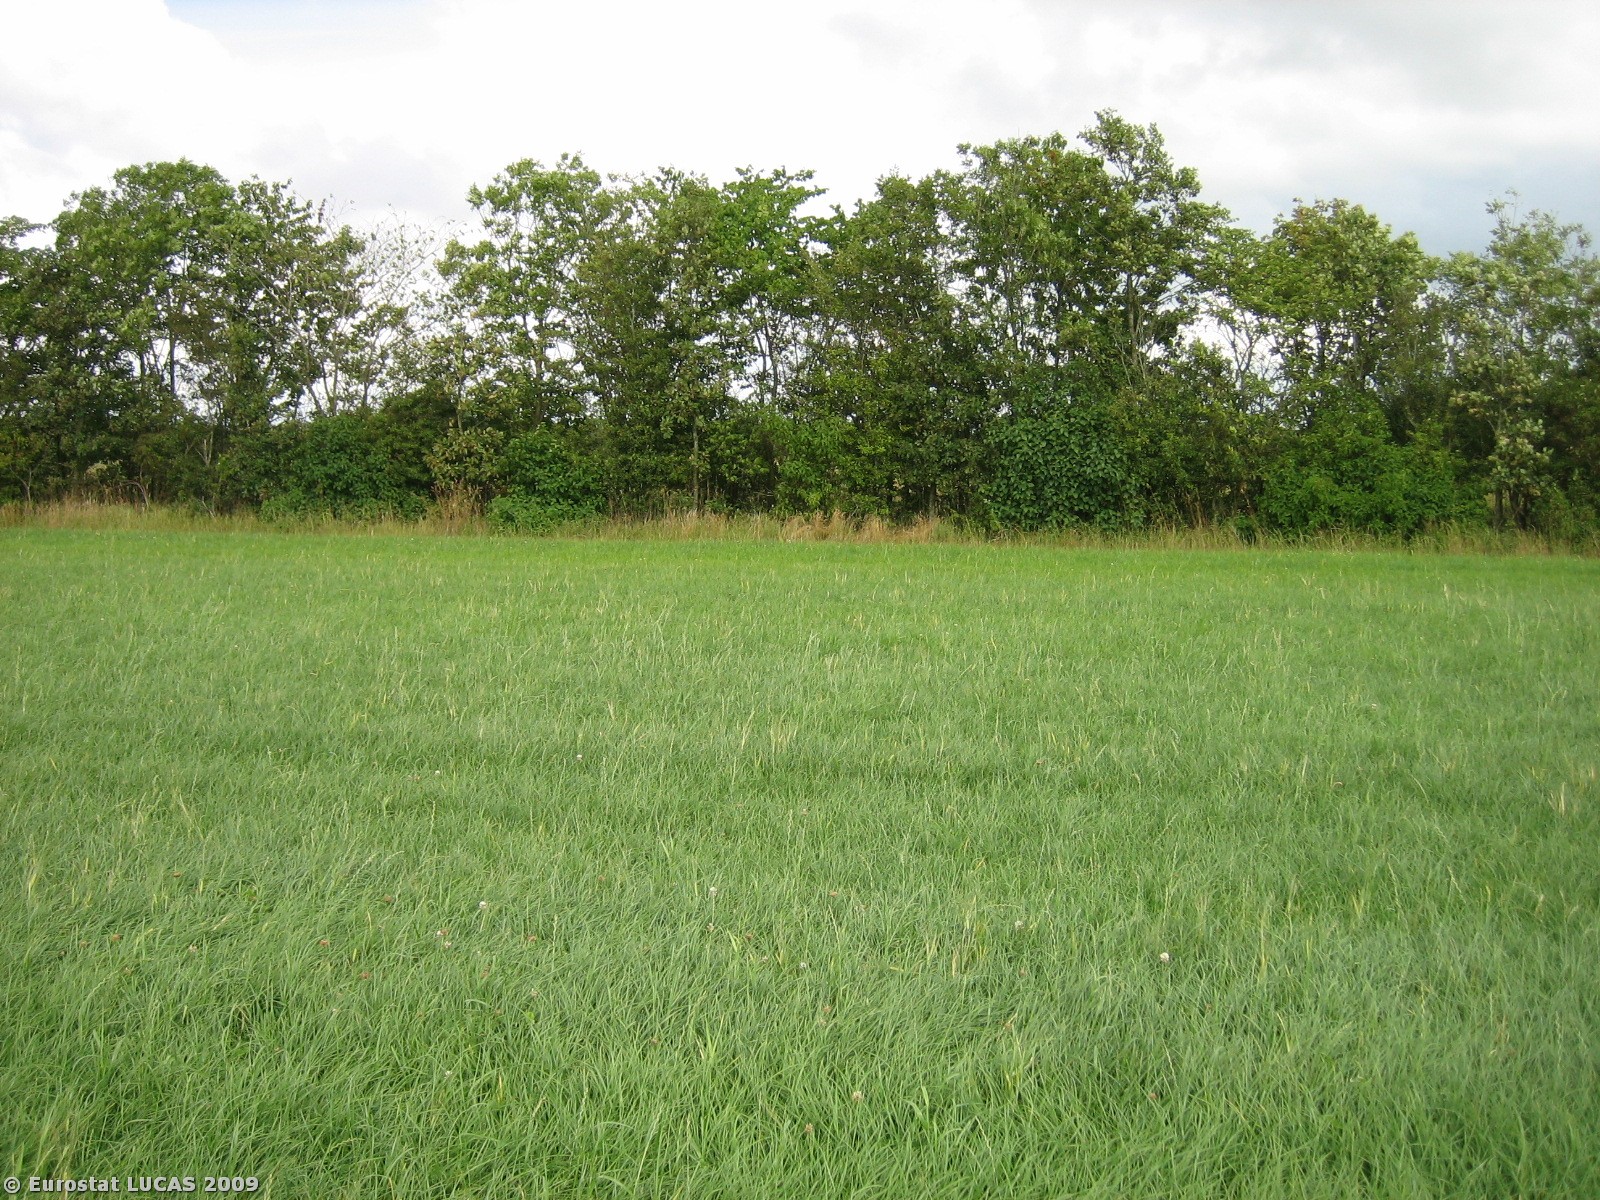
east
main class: Cropland
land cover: Temporary grasslands
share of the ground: > 75 %
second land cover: Rye
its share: < 10 %
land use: Agriculture (excluding fallow land and kitchen gardens)
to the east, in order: Temporary grasslands; Broadleaved woodland; Fences; Tracks; Fences; Grassland without tree/shrub cover; Fences; Abandoned hedges; Barley
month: July
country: DK
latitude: 55.6962
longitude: 8.7443
